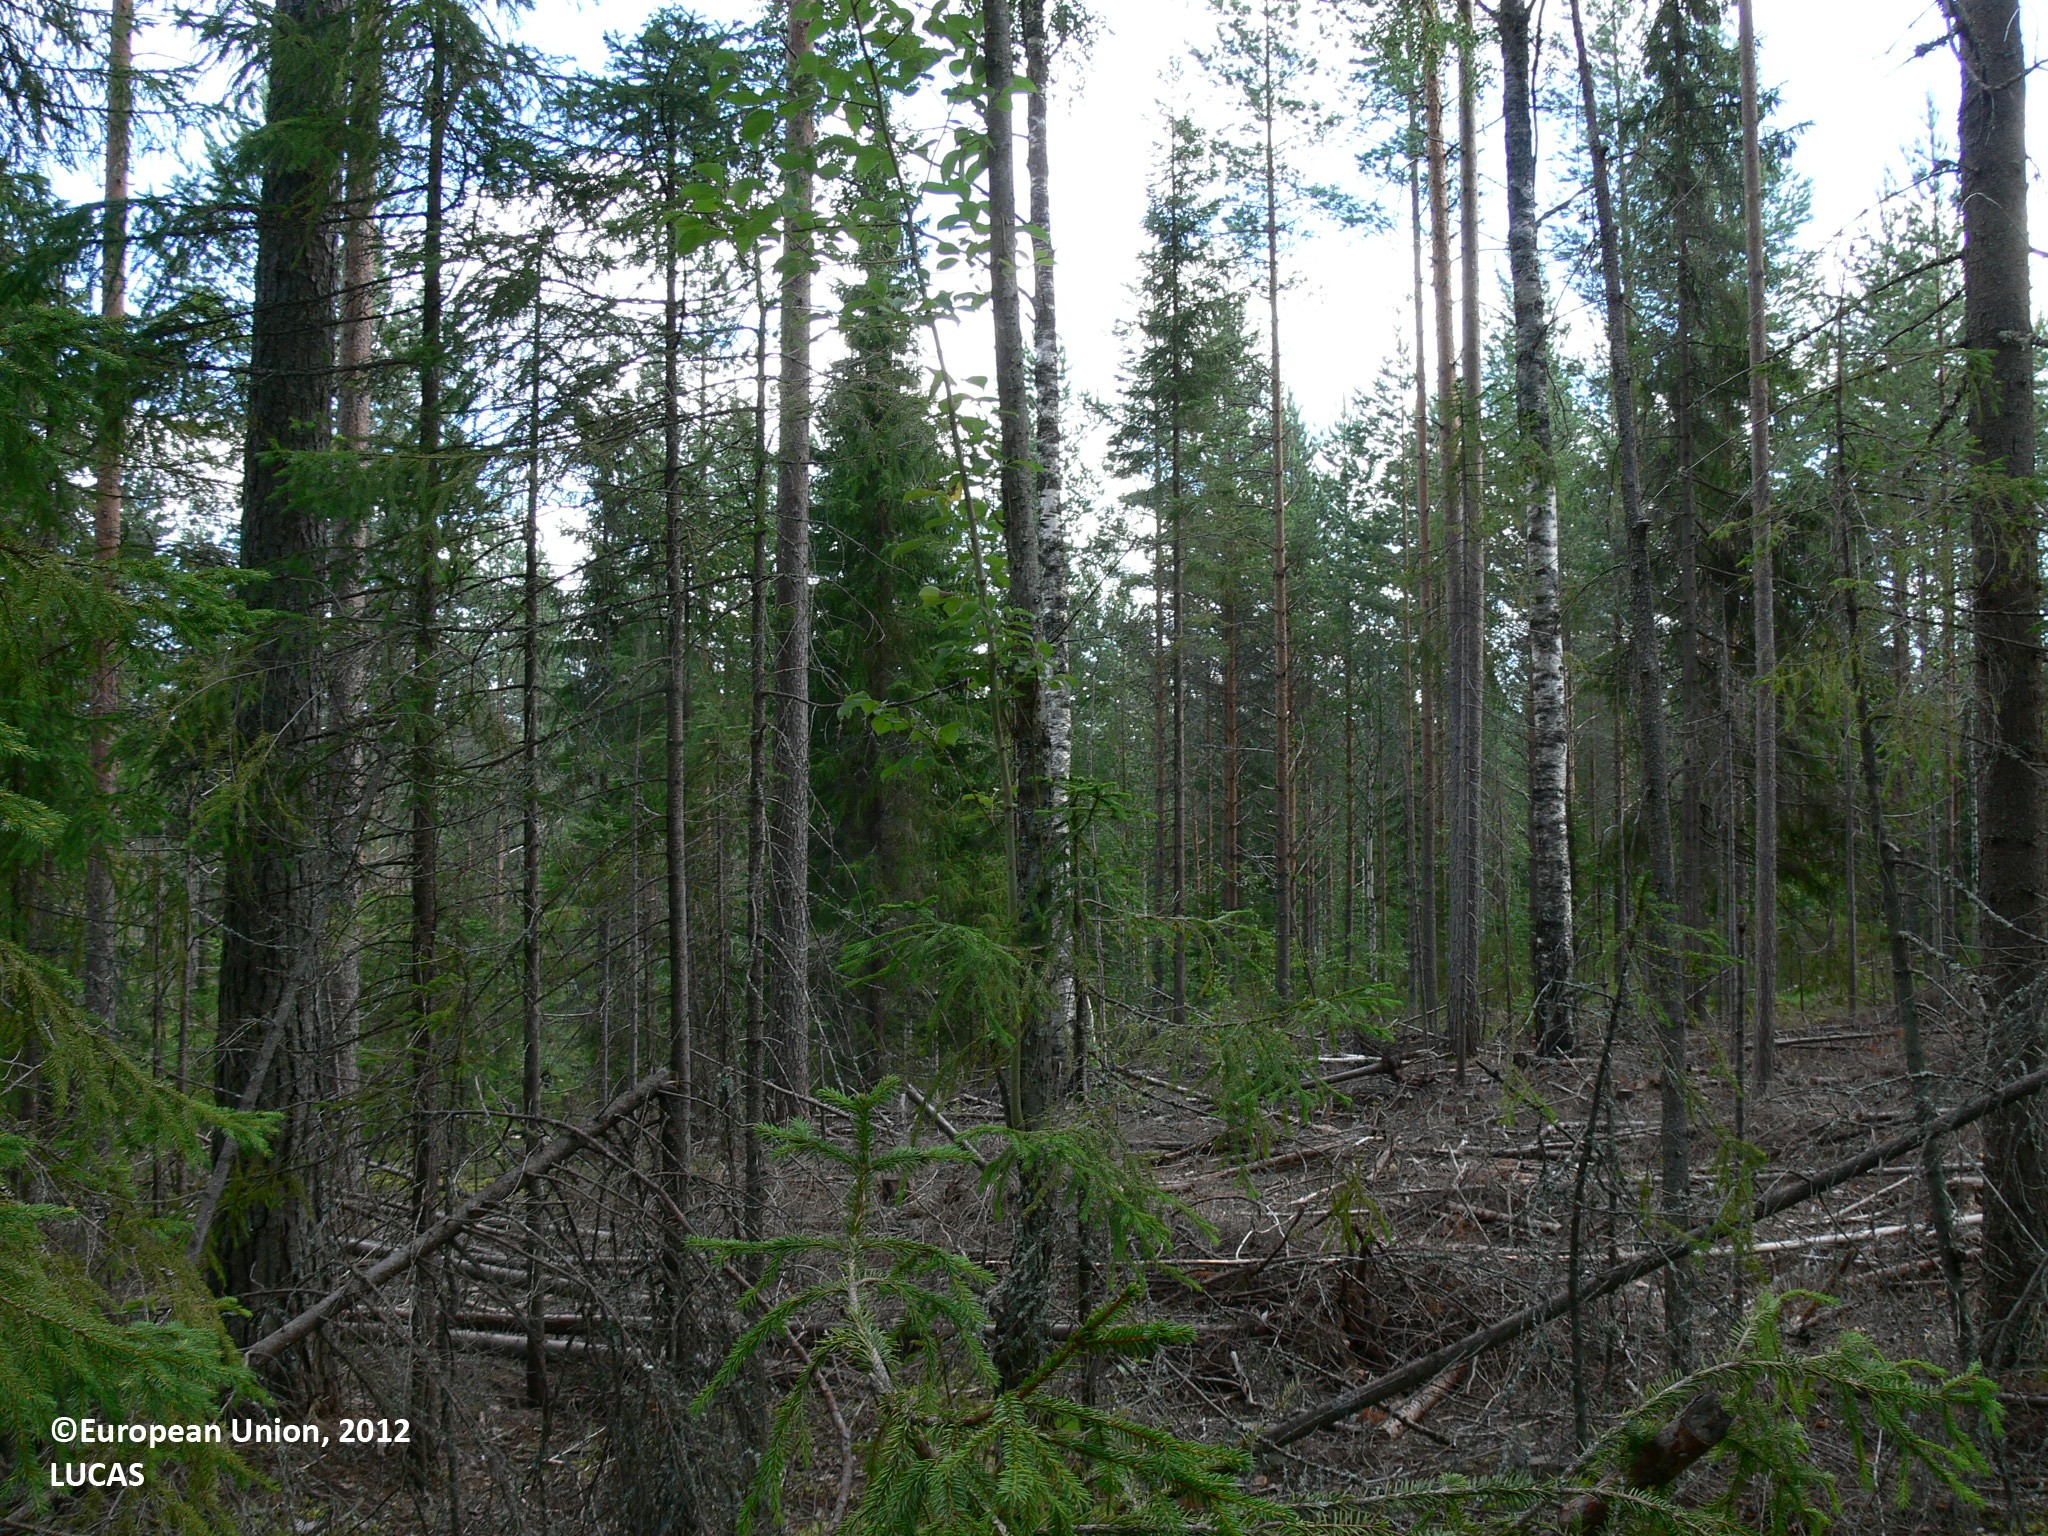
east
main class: Woodland
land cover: Pine dominated coniferous woodland
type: boreal forest
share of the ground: 50 - 75 %
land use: Forestry
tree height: > 5 m
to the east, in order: Pine dominated coniferous woodland; Tracks; Pine dominated coniferous woodland; Ditches and canals; Pine dominated coniferous woodland; Ditches and canals; Pine dominated coniferous woodland; Ditches and canals; Pine dominated coniferous woodland; Ditches and canals; Pine dominated coniferous woodland
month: July
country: FI
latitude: 63.2004
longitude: 29.2461
